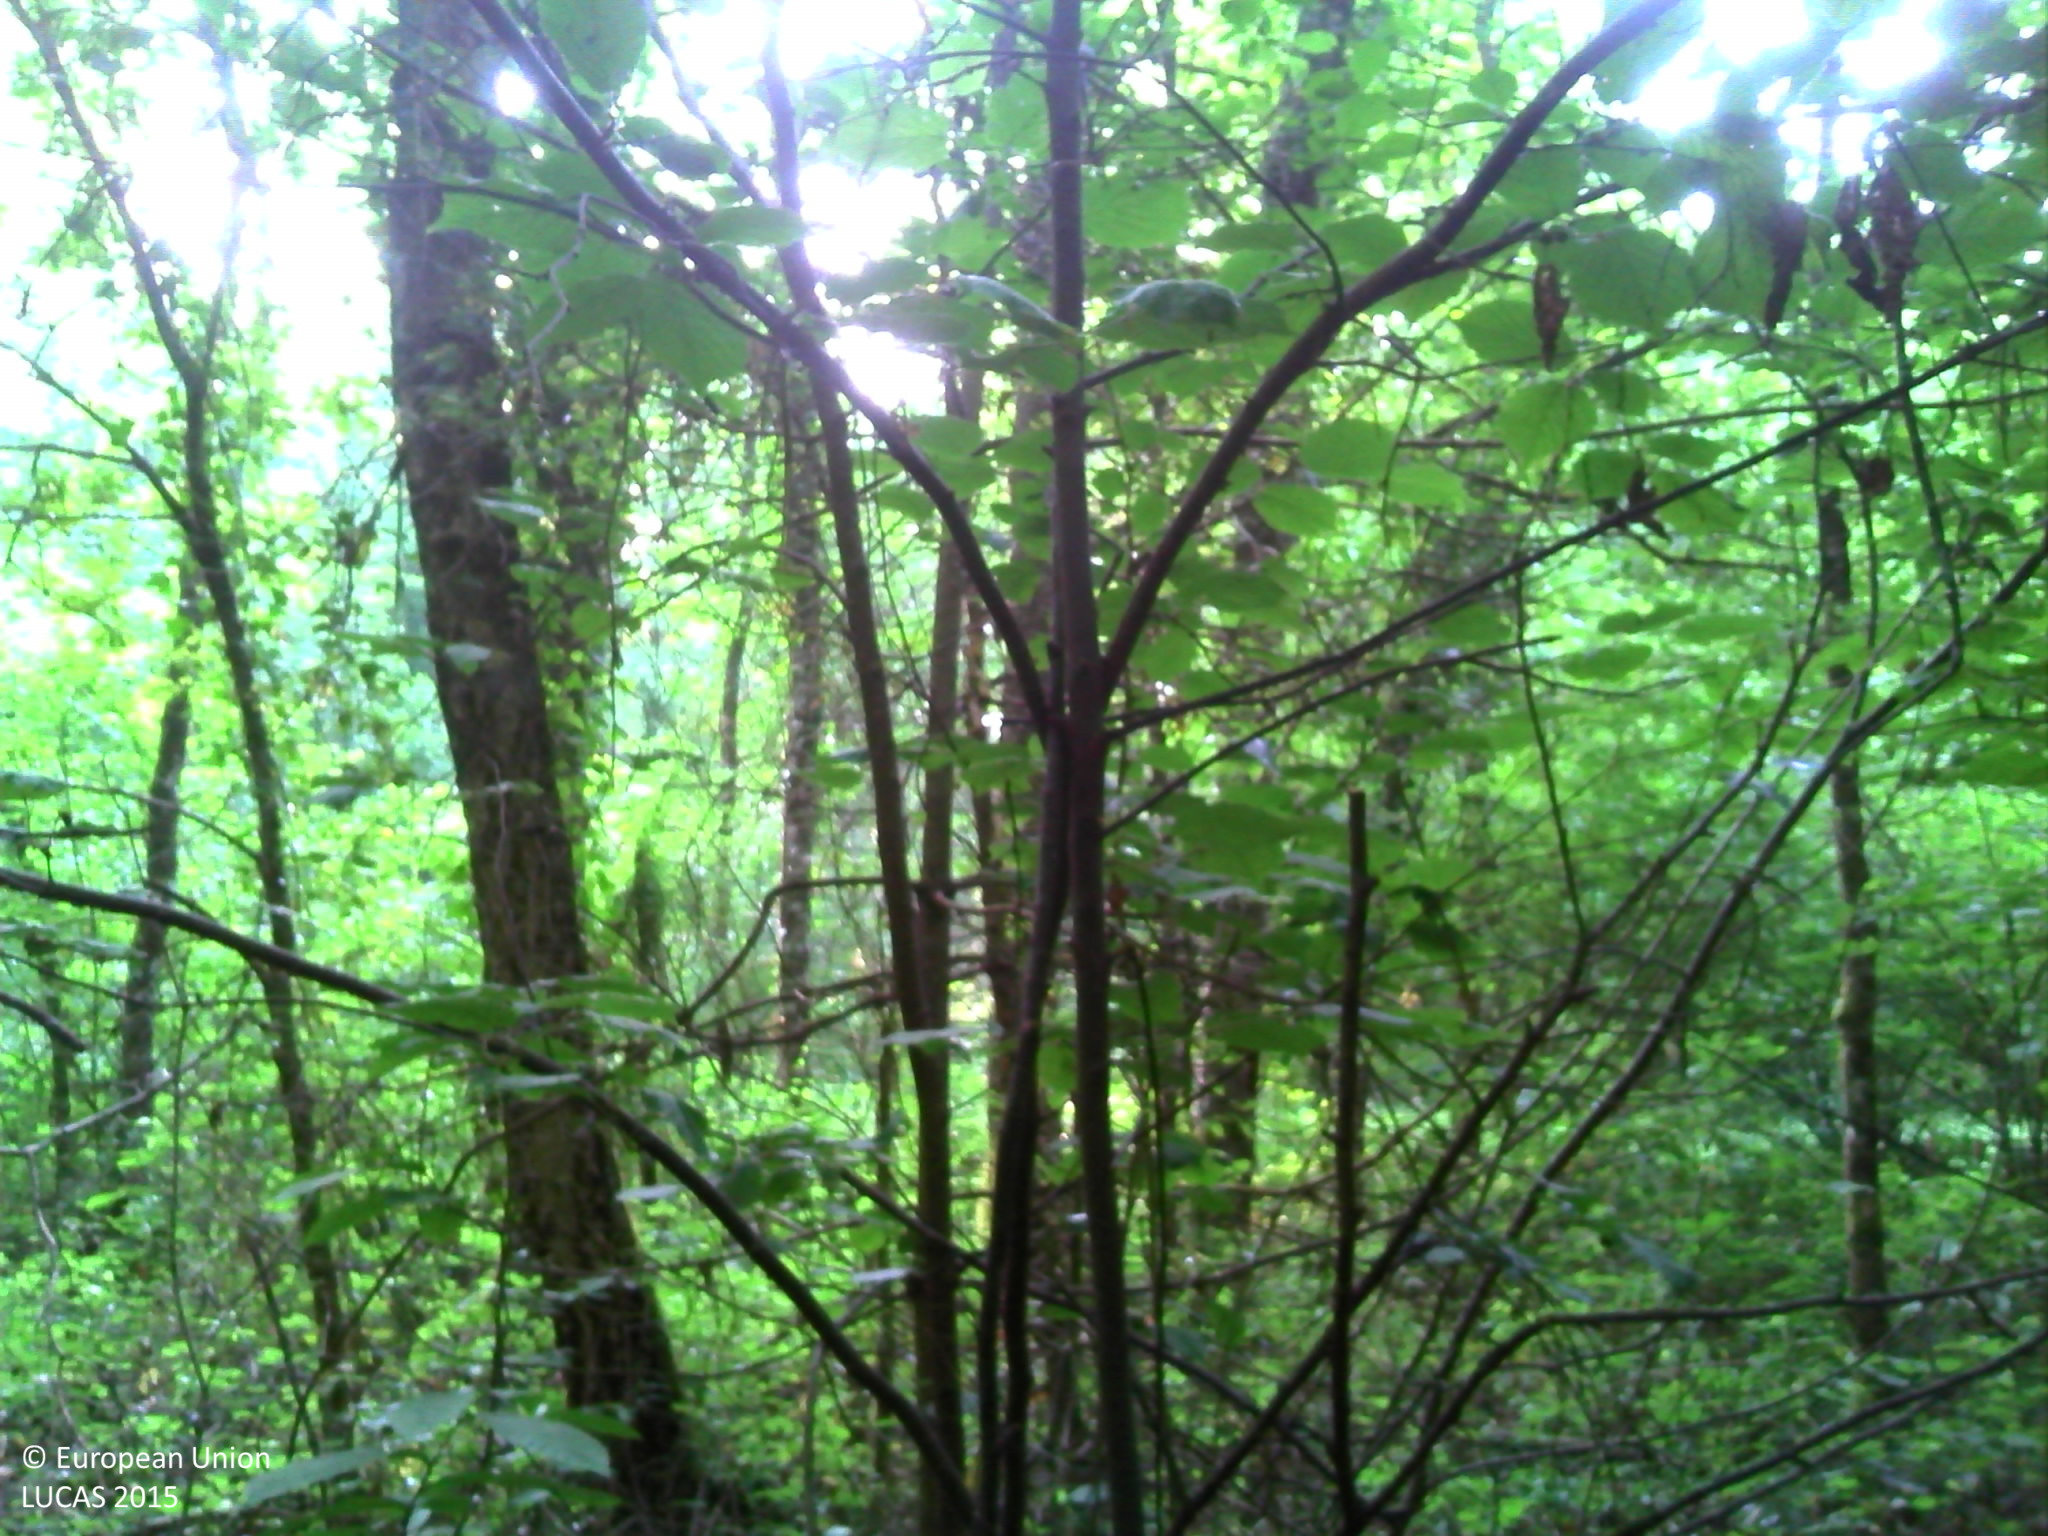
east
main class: Woodland
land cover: Pine dominated mixed woodland
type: hemiboreal forest and nemoral coniferous forest and mixed broadleaved-coniferous forest
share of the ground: > 75 %
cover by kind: coniferous forest trees 45 %, broadleaved forest trees 45 %, herbaceous plants 10 %
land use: Forestry
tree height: > 5 m
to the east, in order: Pine dominated mixed woodland; Ditches and canals; Grass margins; Broadleaved woodland; Tracks; Grass margins; Ditches and canals; Fences; Grassland without tree/shrub cover; Inland fresh water bodies
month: June
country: FR
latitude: 47.7178
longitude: 2.0306
